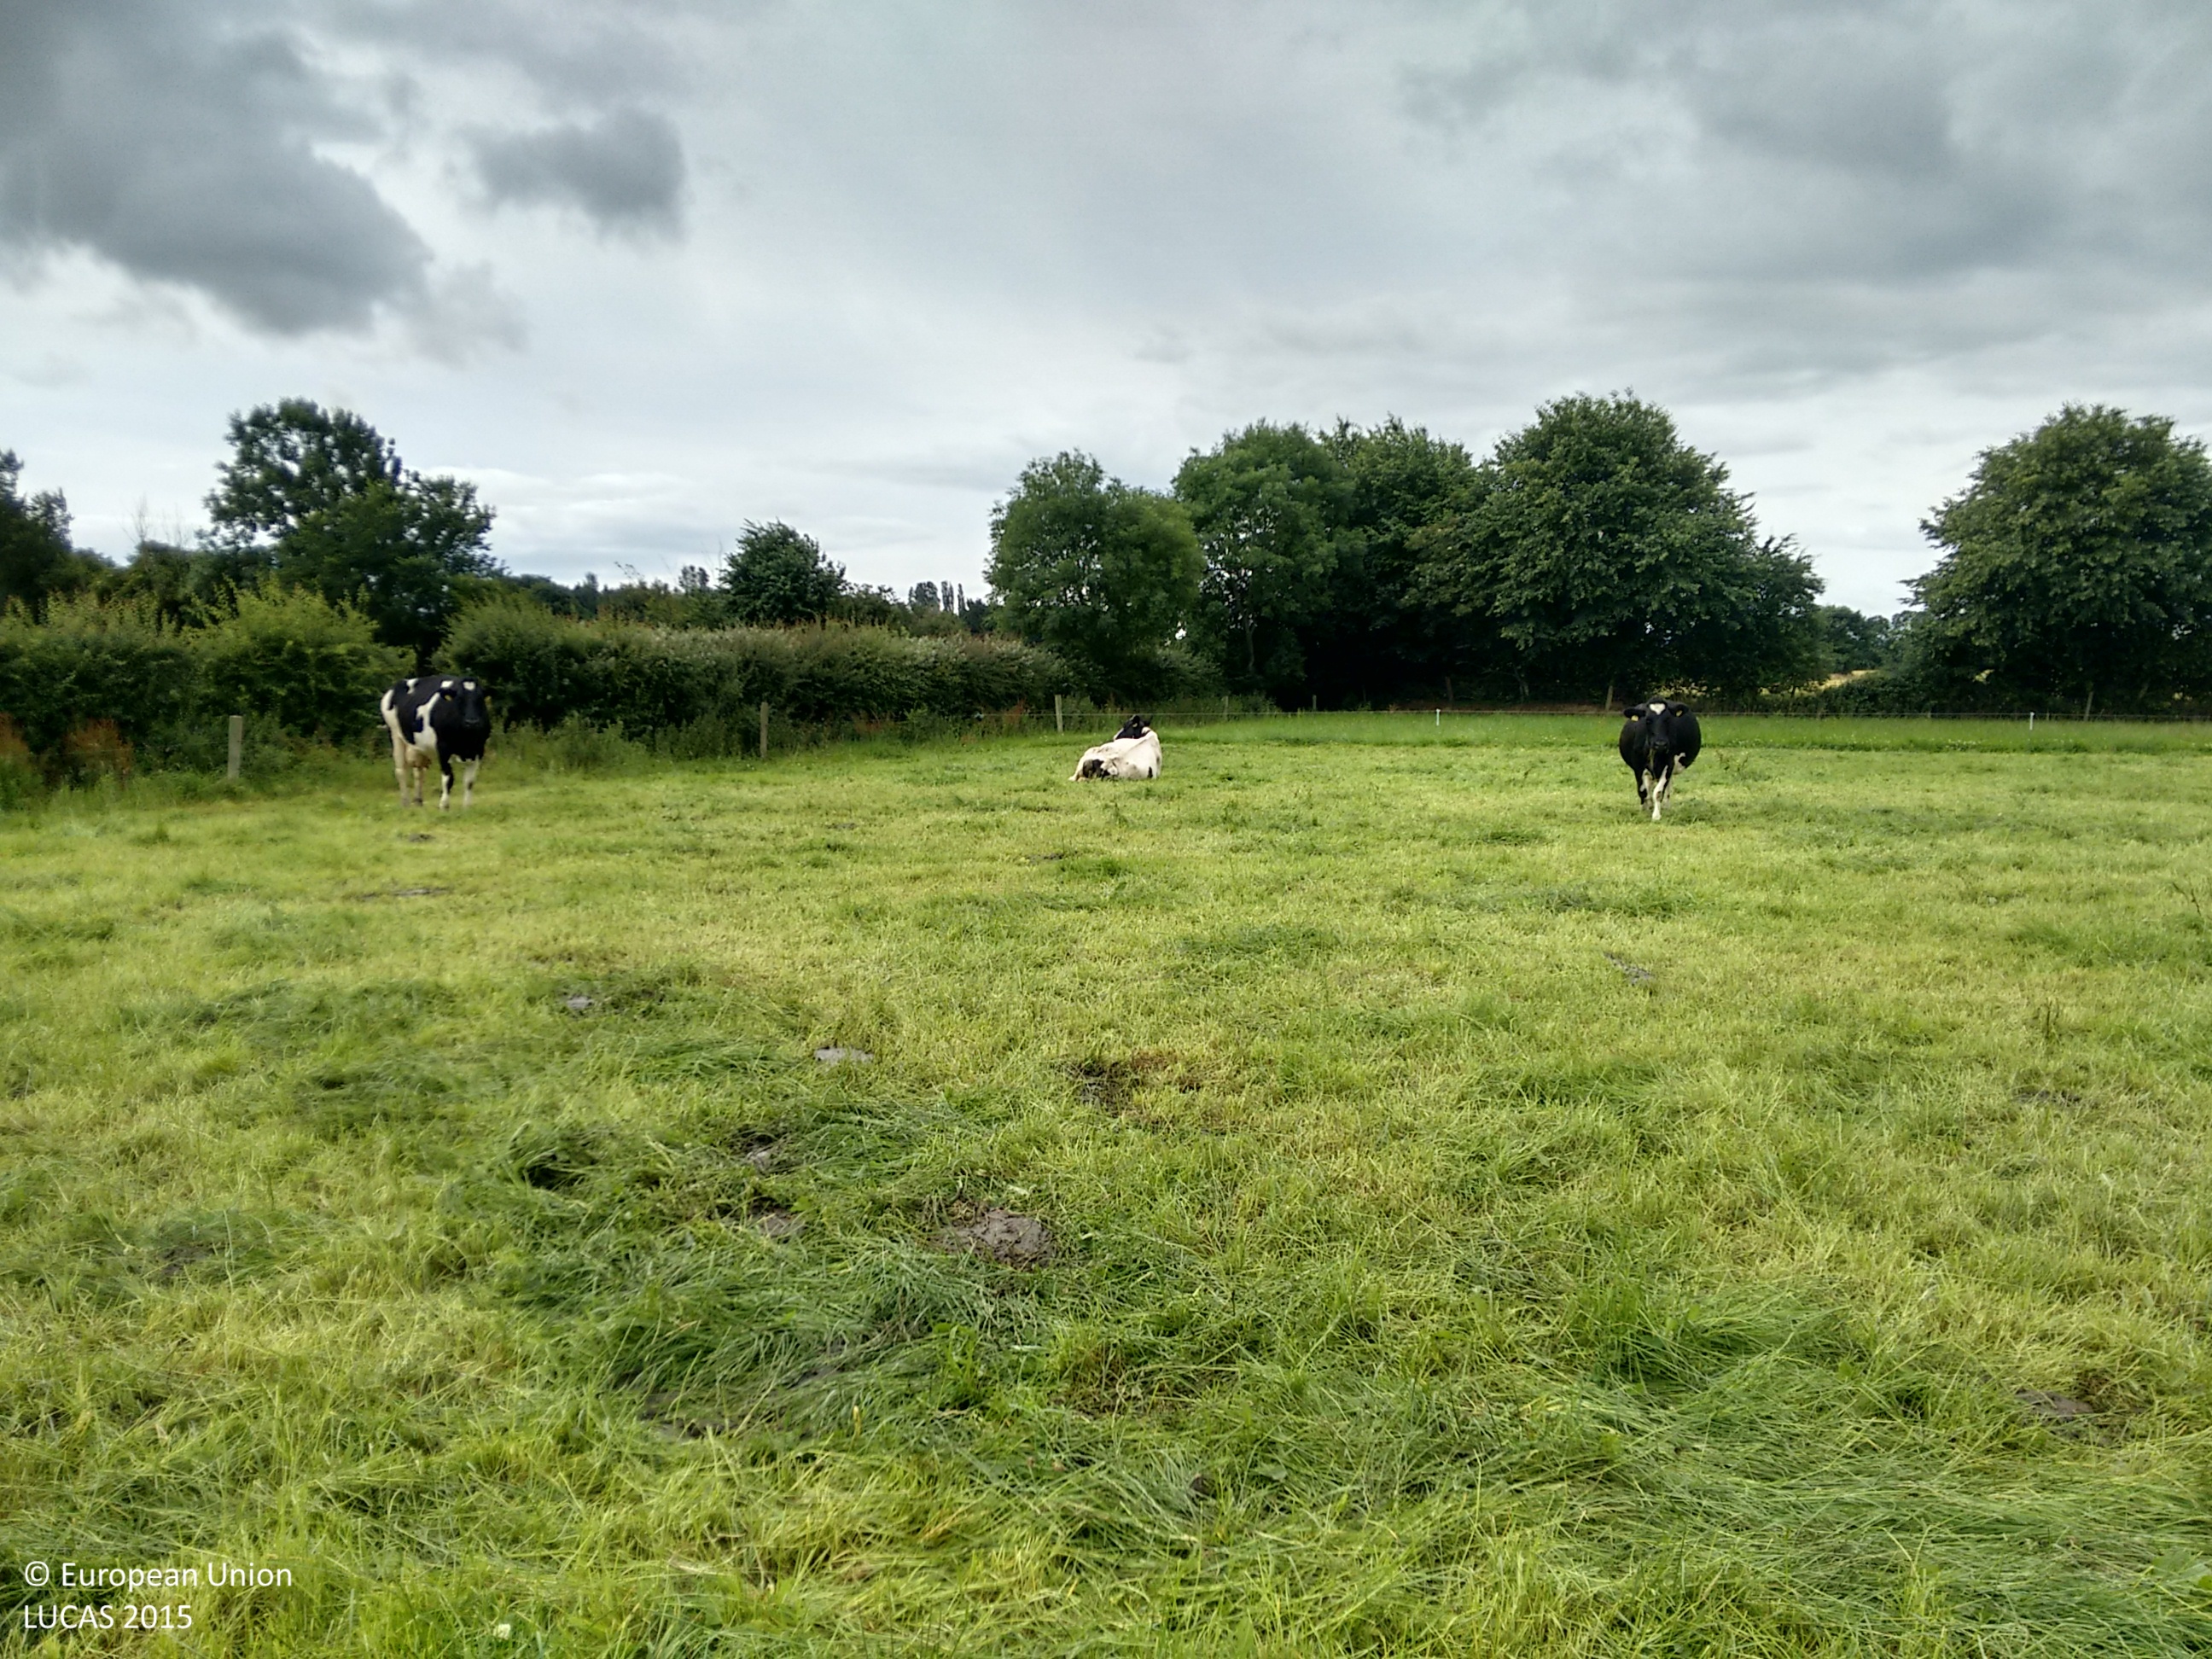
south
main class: Grassland
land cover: Grassland without tree/shrub cover
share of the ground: > 75 %
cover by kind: herbaceous plants 100 %
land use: Agriculture (excluding fallow land and kitchen gardens)
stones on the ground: < 10 %
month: July
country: IE
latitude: 52.6253
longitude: -7.2733
